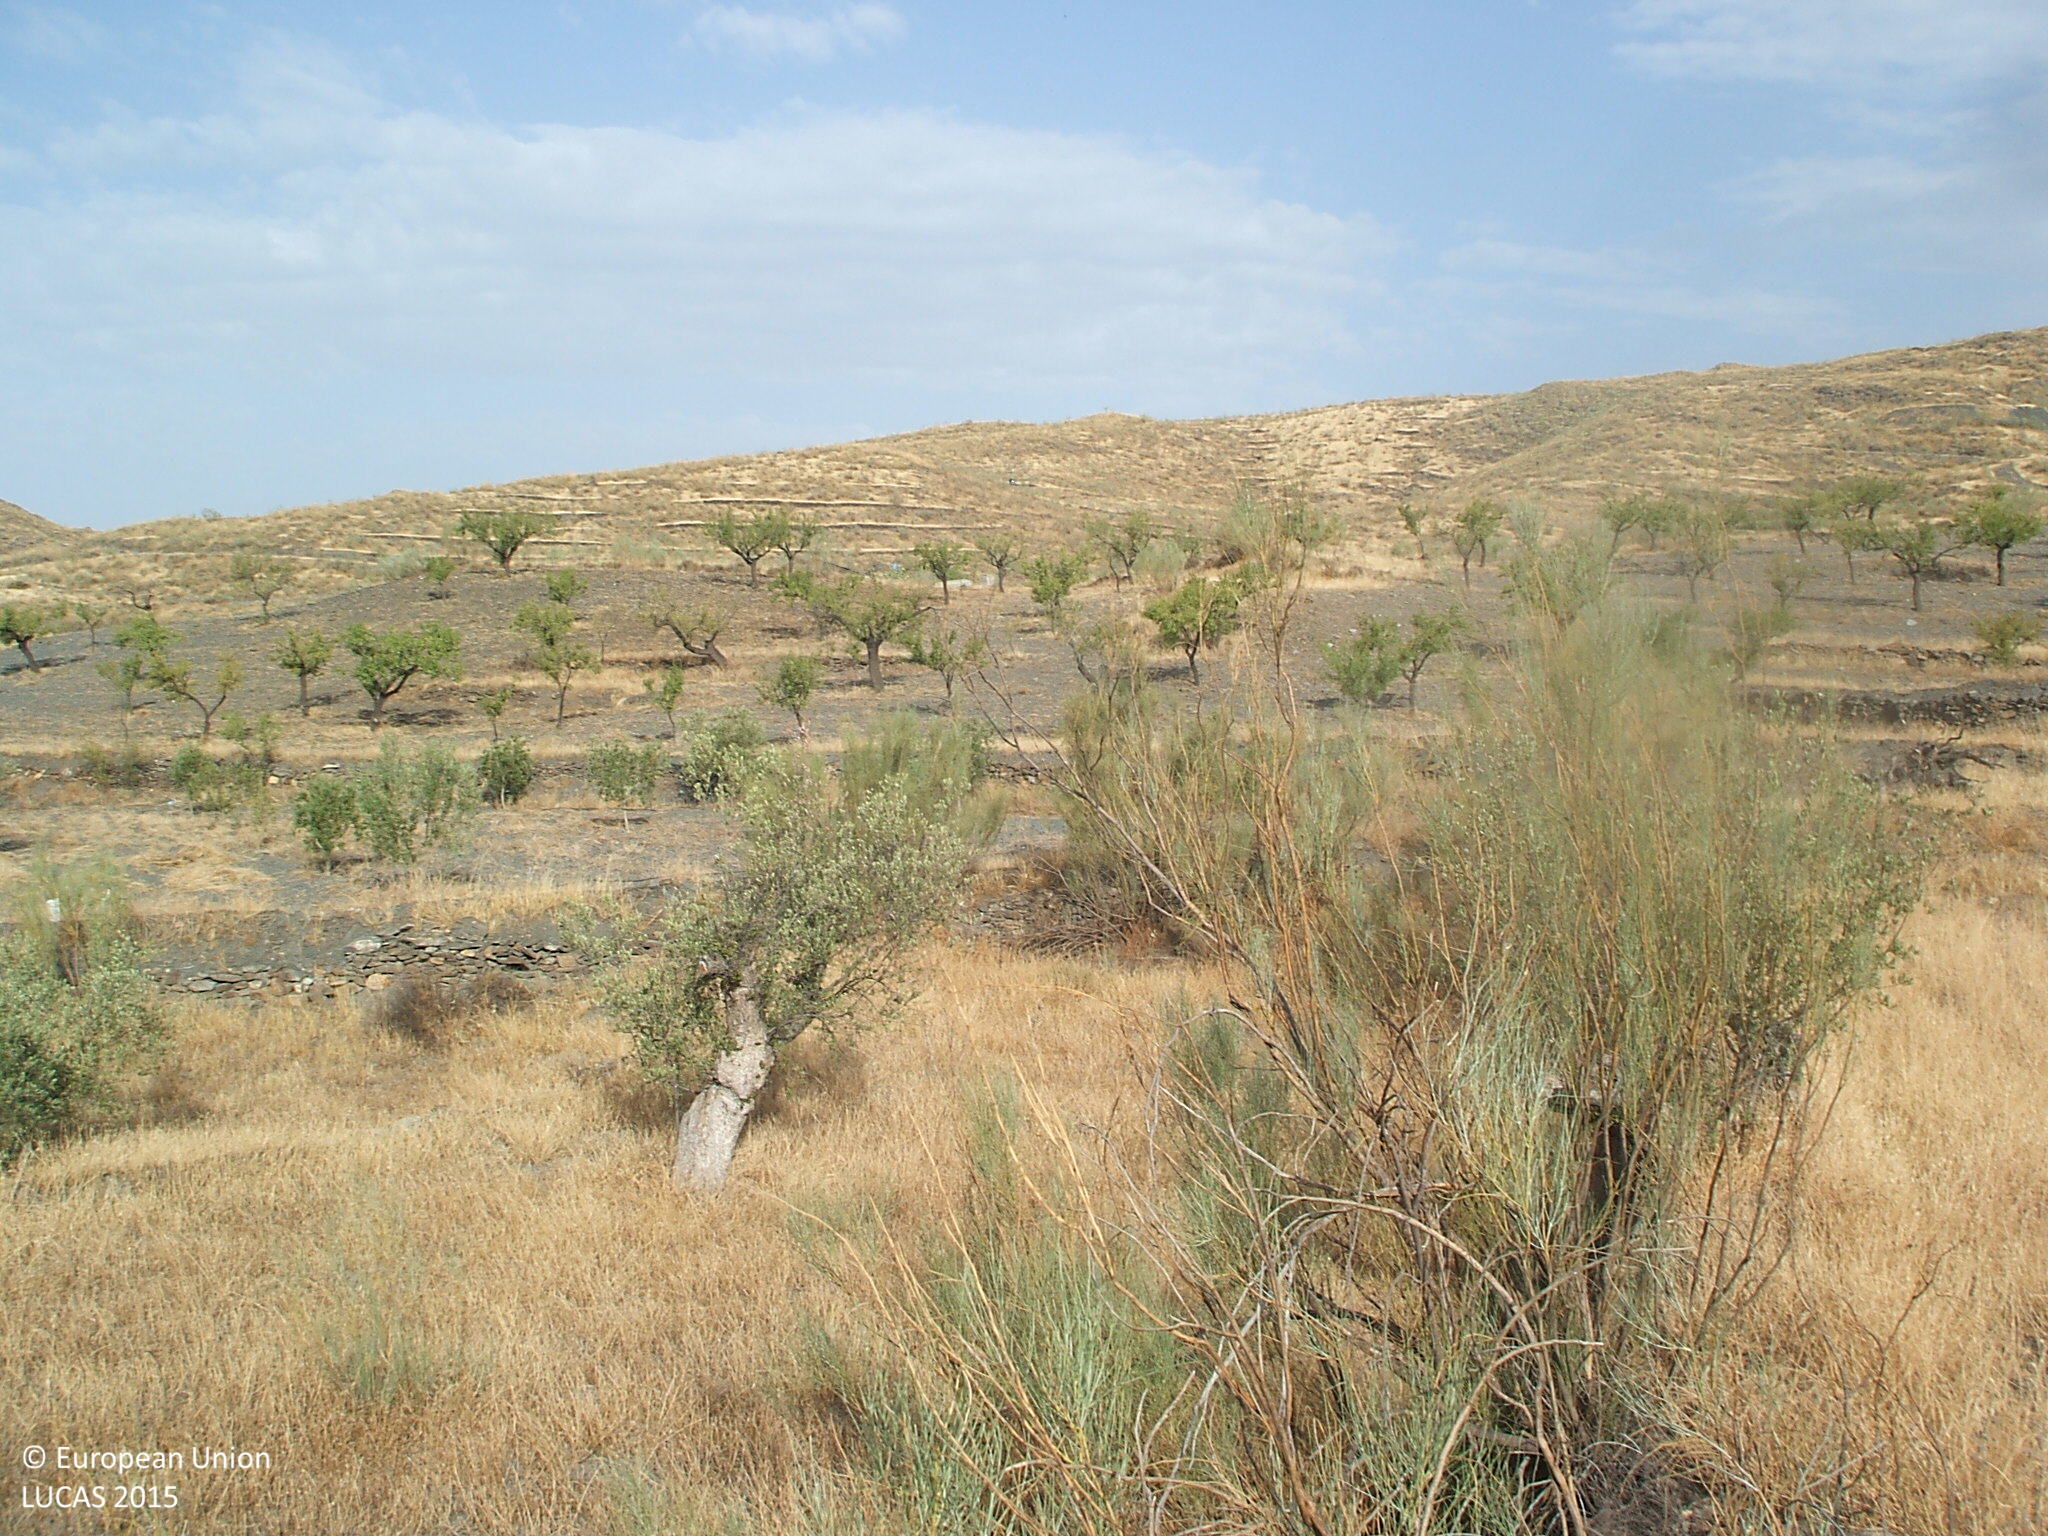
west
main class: Cropland
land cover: Olive groves
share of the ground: 10 - 25 %
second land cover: Nuts trees
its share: 10 - 25 %
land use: Agriculture (excluding fallow land and kitchen gardens)
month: July
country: ES
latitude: 37.1823
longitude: -2.3134
